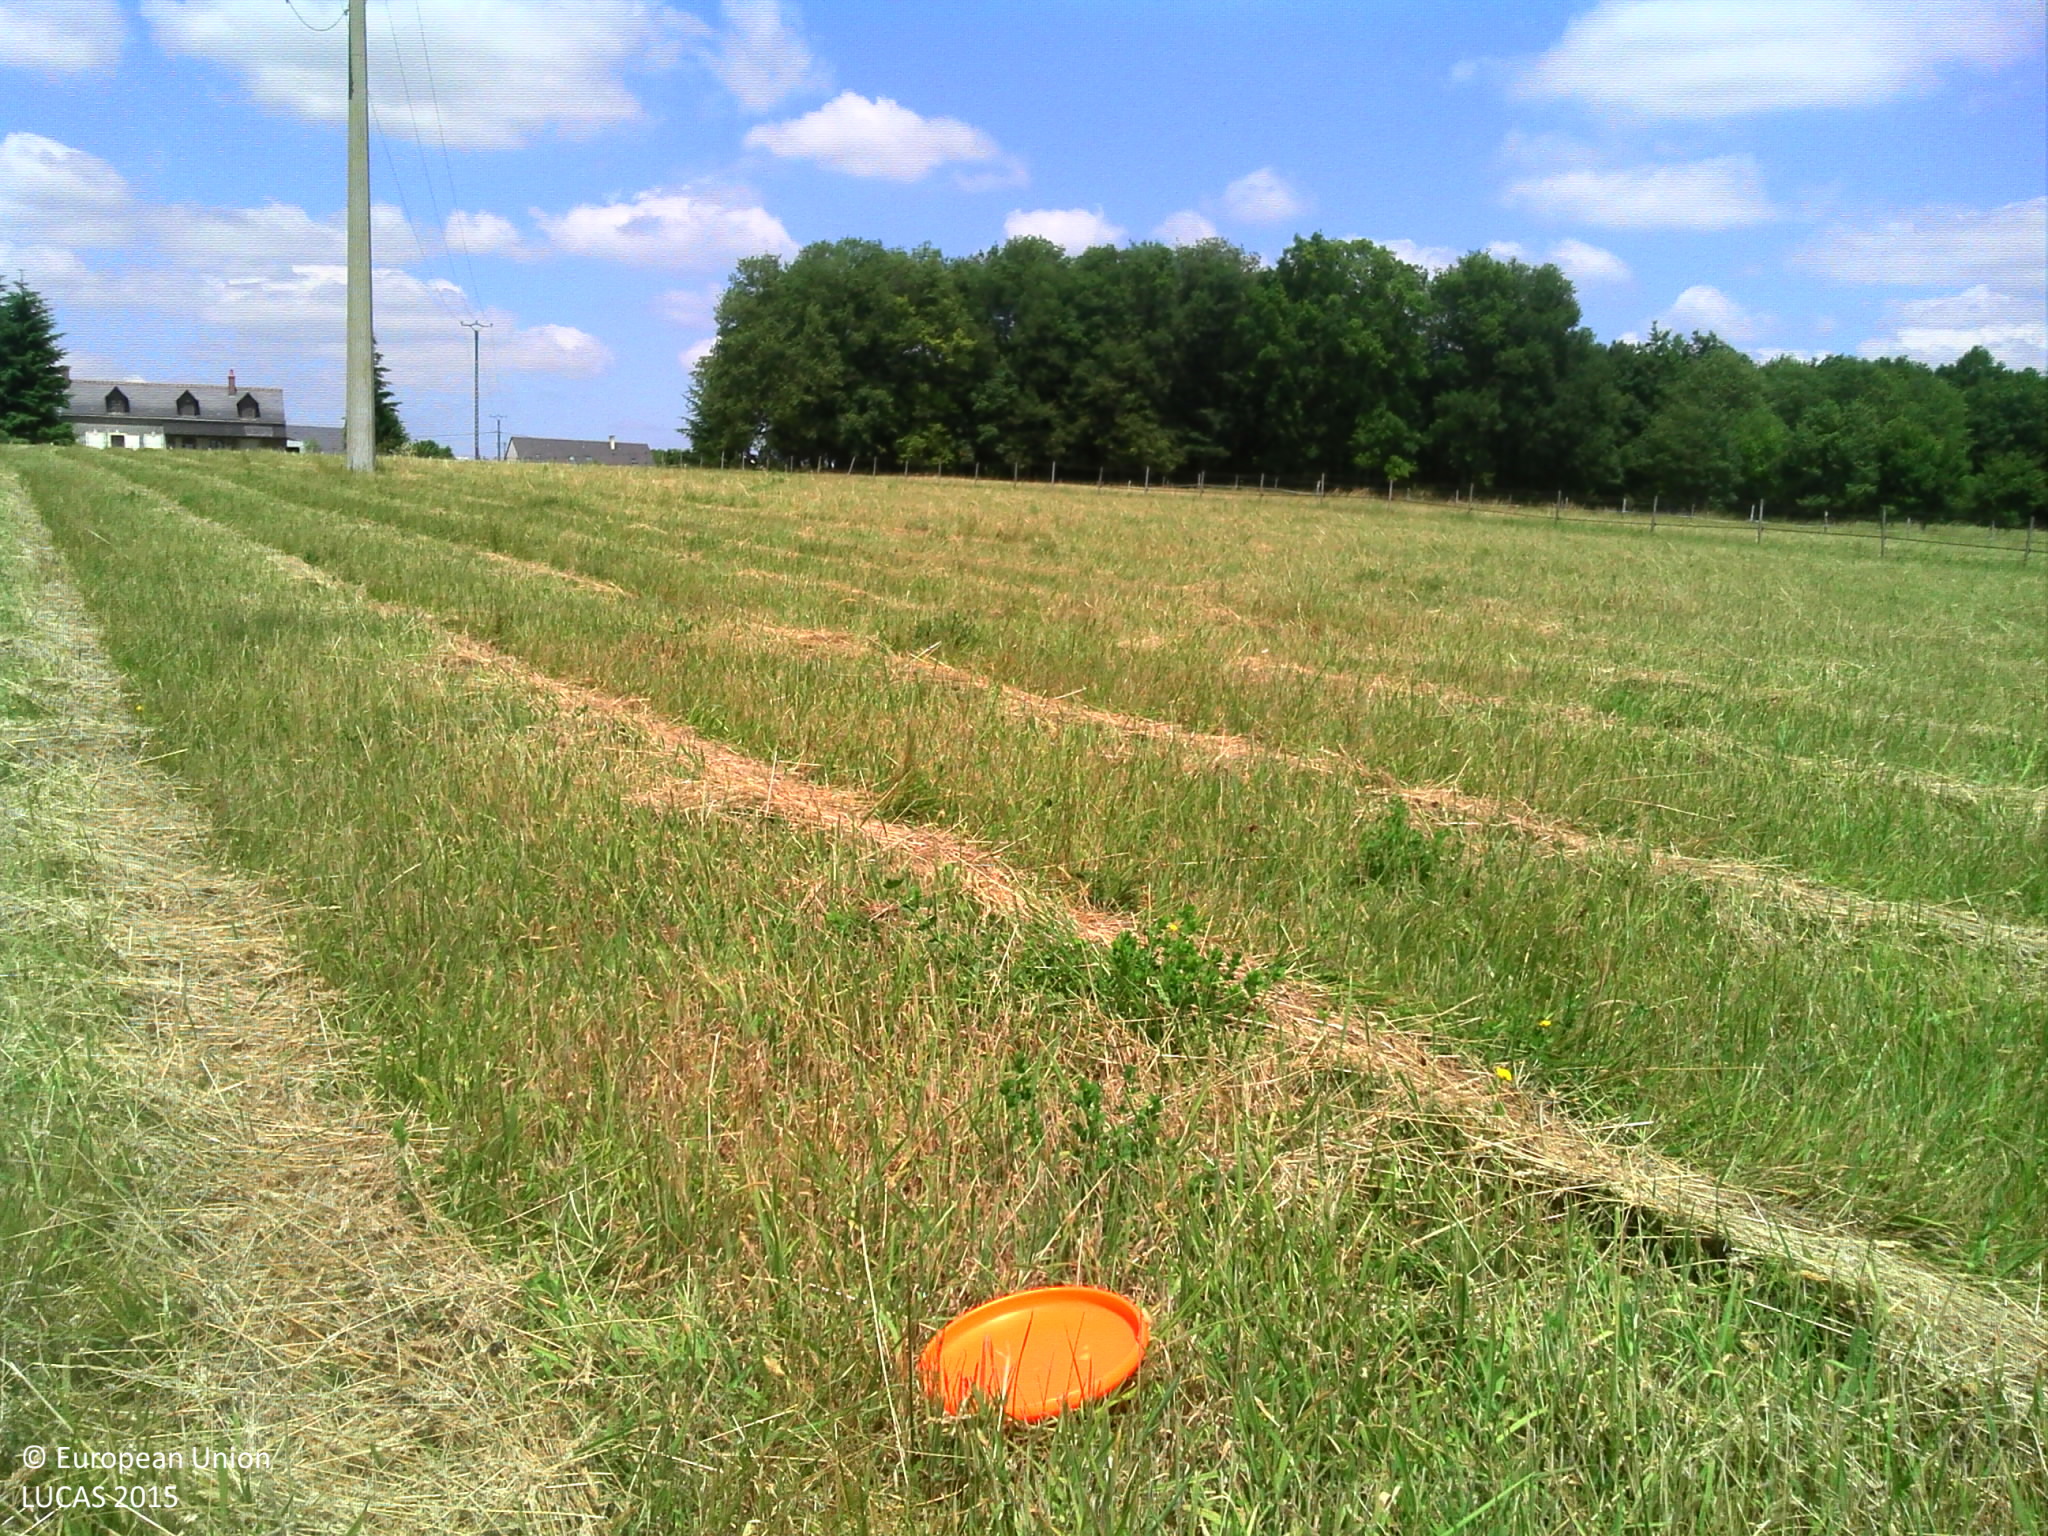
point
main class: Grassland
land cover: Grassland without tree/shrub cover
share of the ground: > 75 %
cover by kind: herbaceous plants 100 %
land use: Agriculture (excluding fallow land and kitchen gardens)
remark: Harvested field
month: June
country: FR
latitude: 47.4319
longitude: 0.4992
